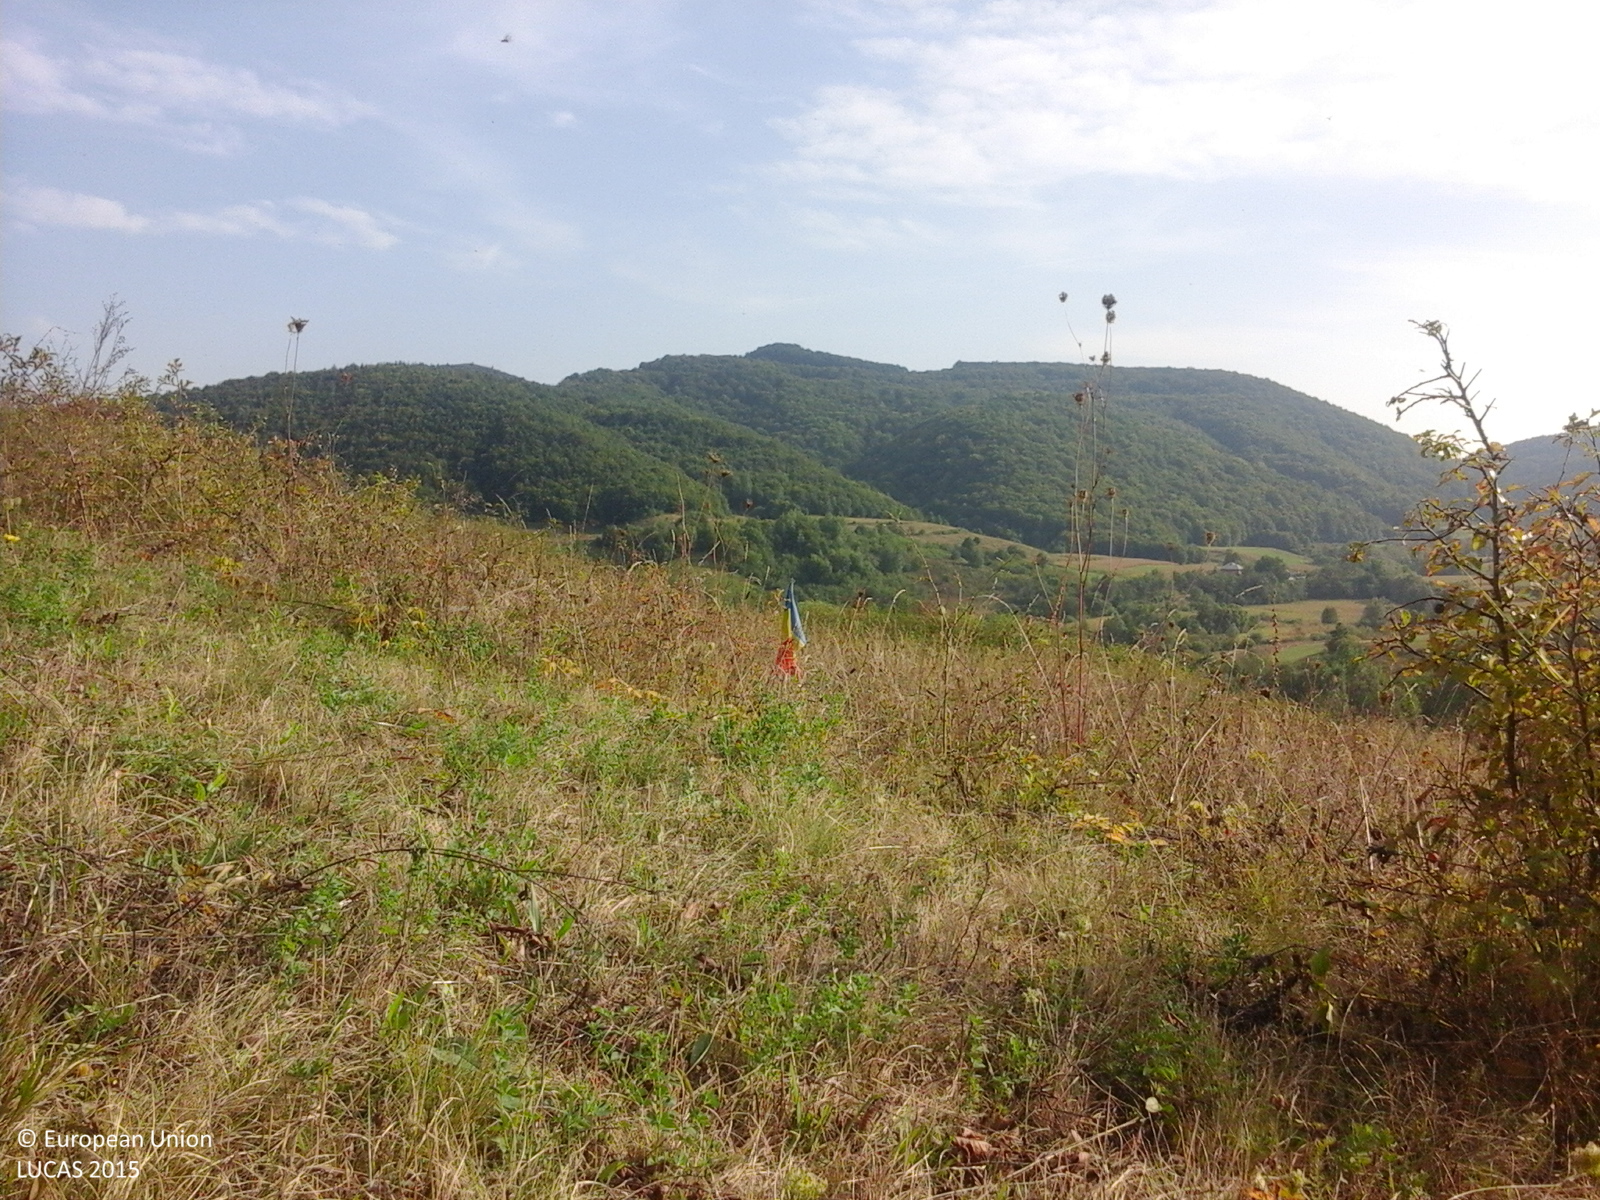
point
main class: Grassland
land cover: Spontaneously vegetated surfaces
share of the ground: > 75 %
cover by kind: herbaceous plants 100 %
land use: Fallow land
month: September
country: RO
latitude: 47.1996
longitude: 23.5504
